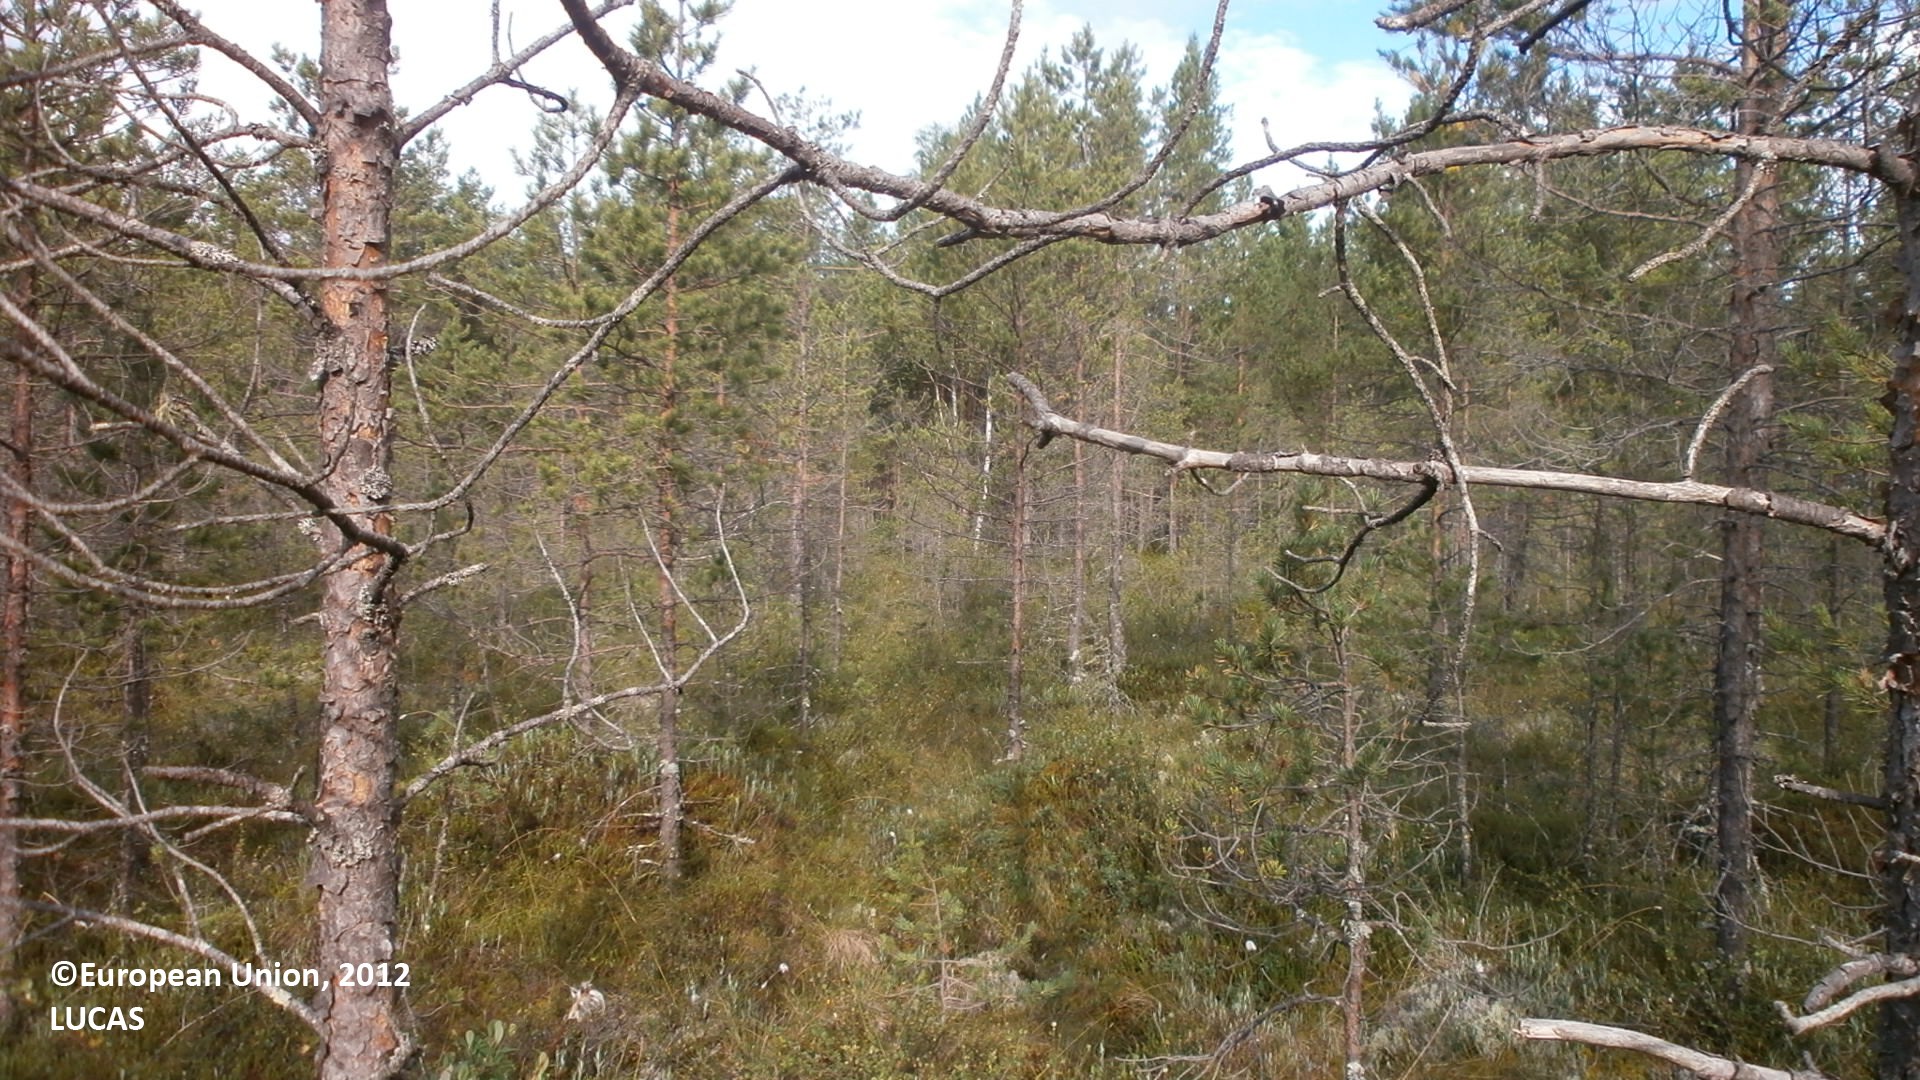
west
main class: Woodland
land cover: Pine dominated coniferous woodland
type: mire and swamp forests
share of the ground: 25 - 50 %
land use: Forestry
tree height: > 5 m
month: July
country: FI
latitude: 64.0696
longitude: 23.9817
